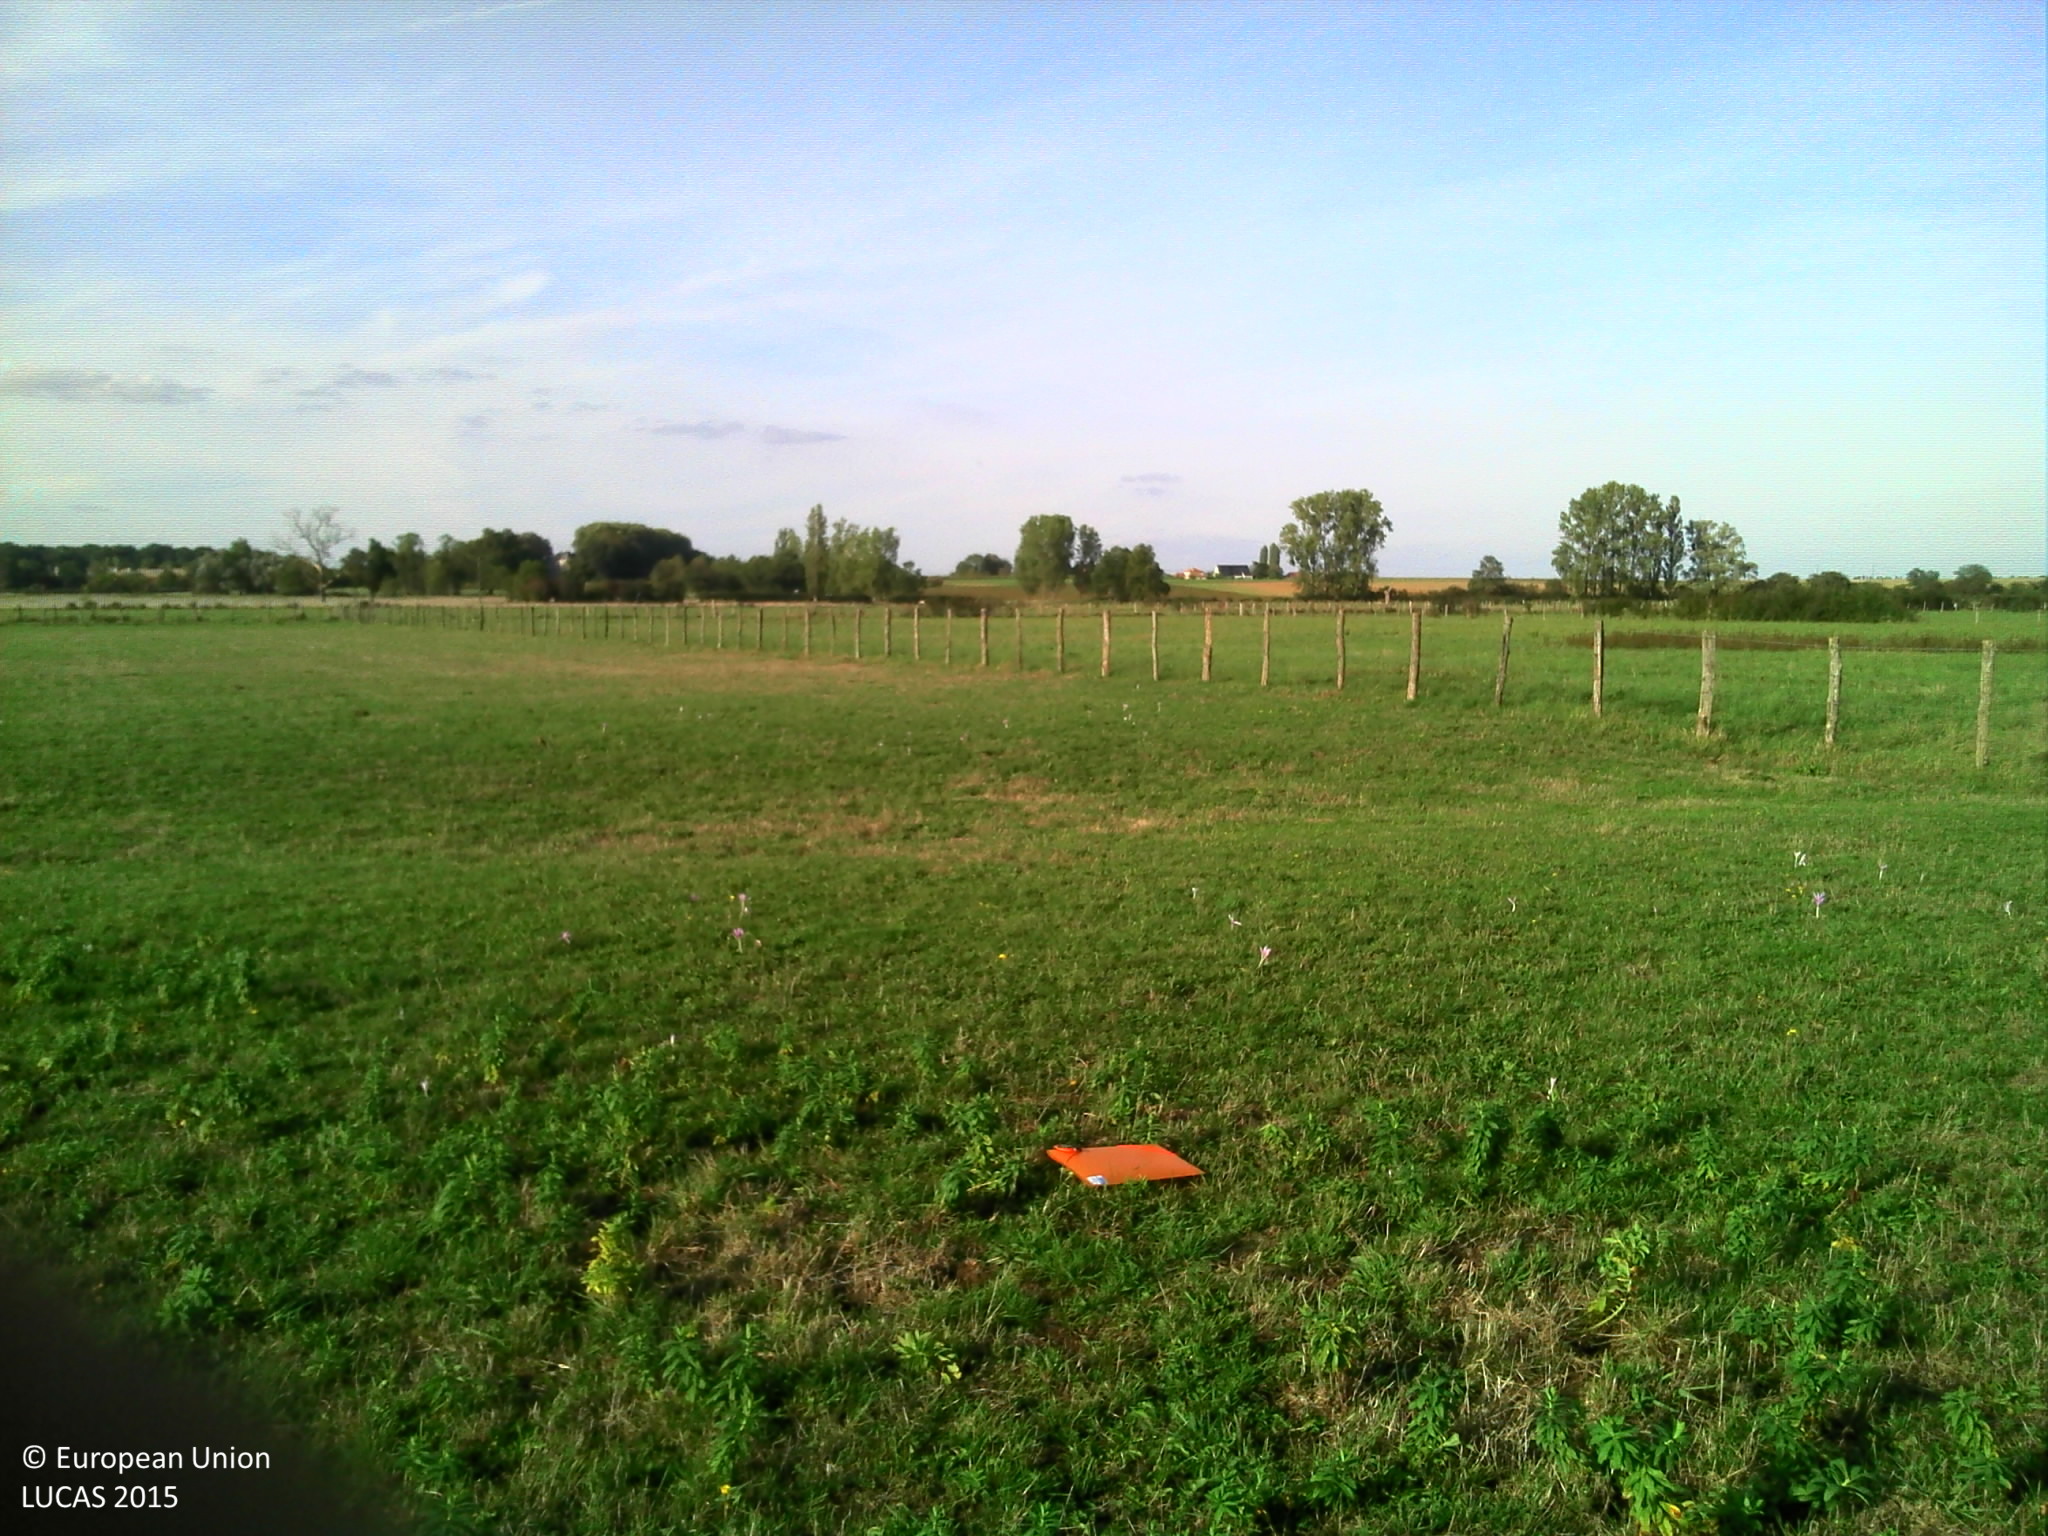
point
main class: Grassland
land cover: Grassland without tree/shrub cover
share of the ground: > 75 %
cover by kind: herbaceous plants 100 %
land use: Agriculture (excluding fallow land and kitchen gardens)
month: September
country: FR
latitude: 46.9496
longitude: 4.8637
